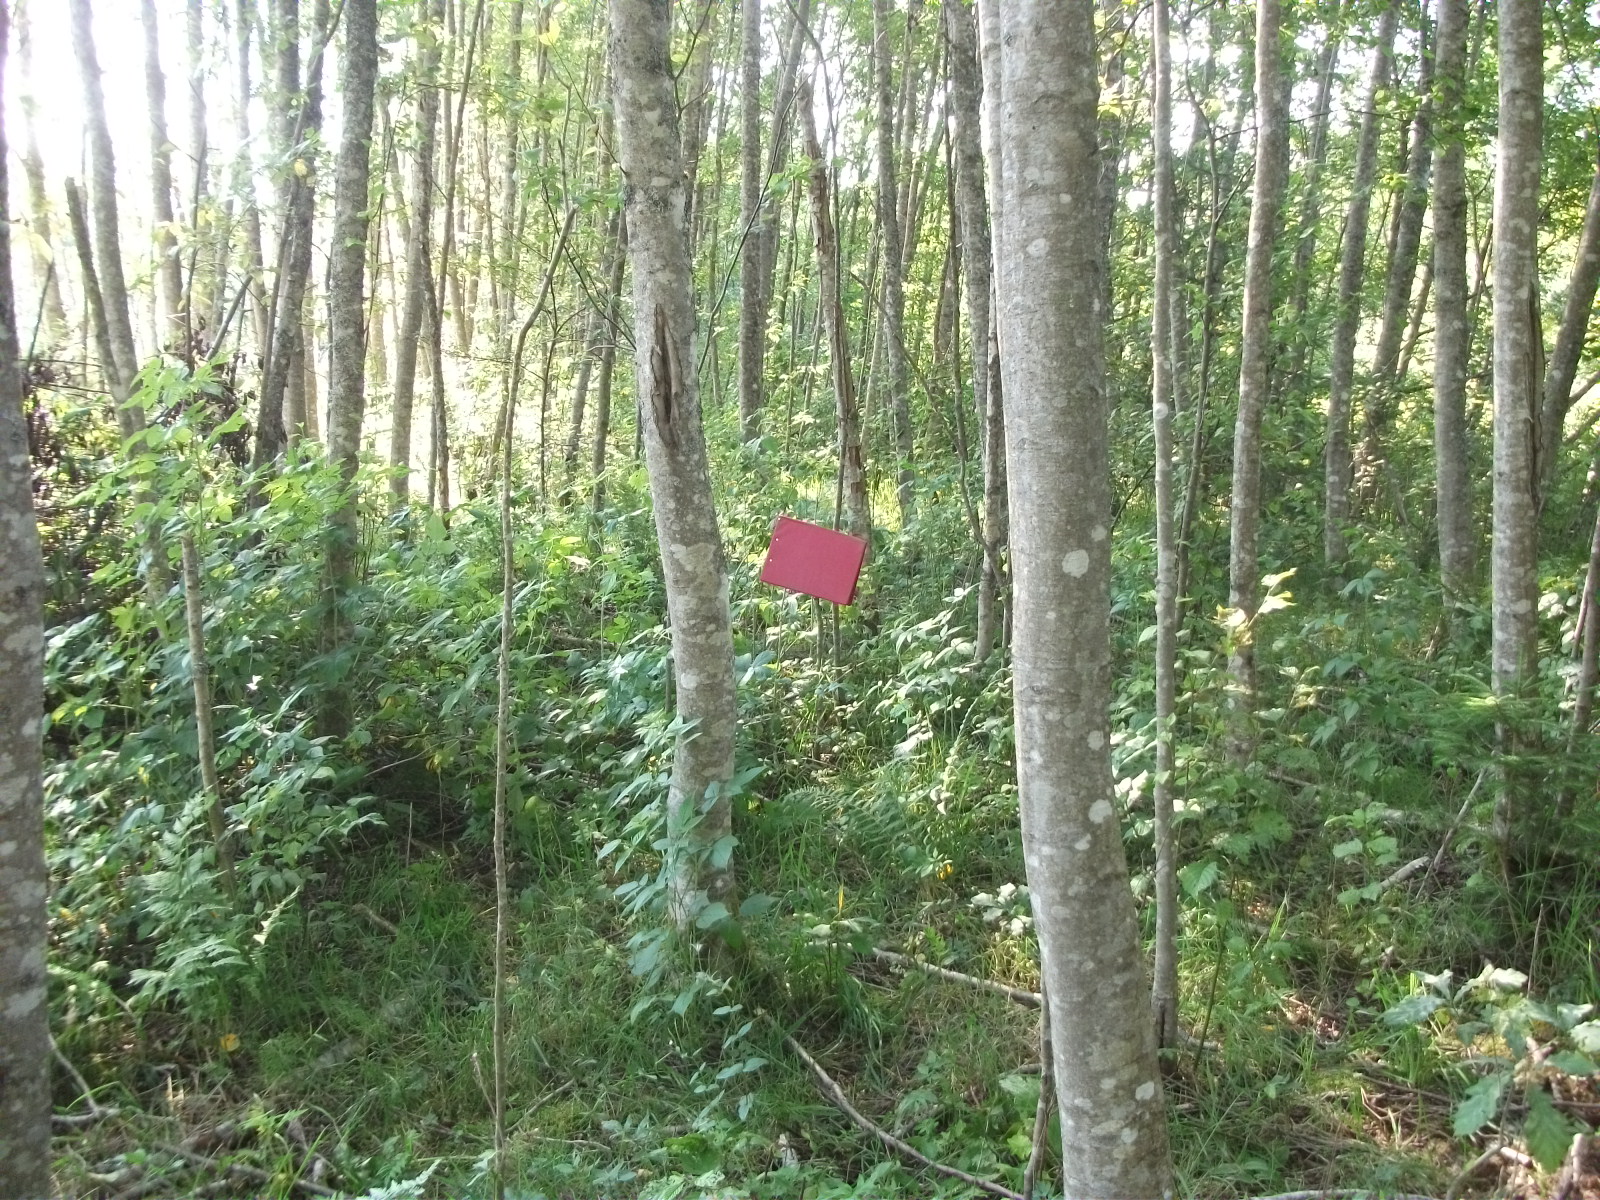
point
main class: Woodland
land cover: Broadleaved woodland
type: non-riverine alder, birch or aspen forest
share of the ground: > 75 %
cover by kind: broadleaved forest trees 85 %, herbaceous plants 10 %, shrubs 5 %
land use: Agriculture (excluding fallow land and kitchen gardens)
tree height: > 5 m
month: August
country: LV
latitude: 56.8061
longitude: 25.7326
